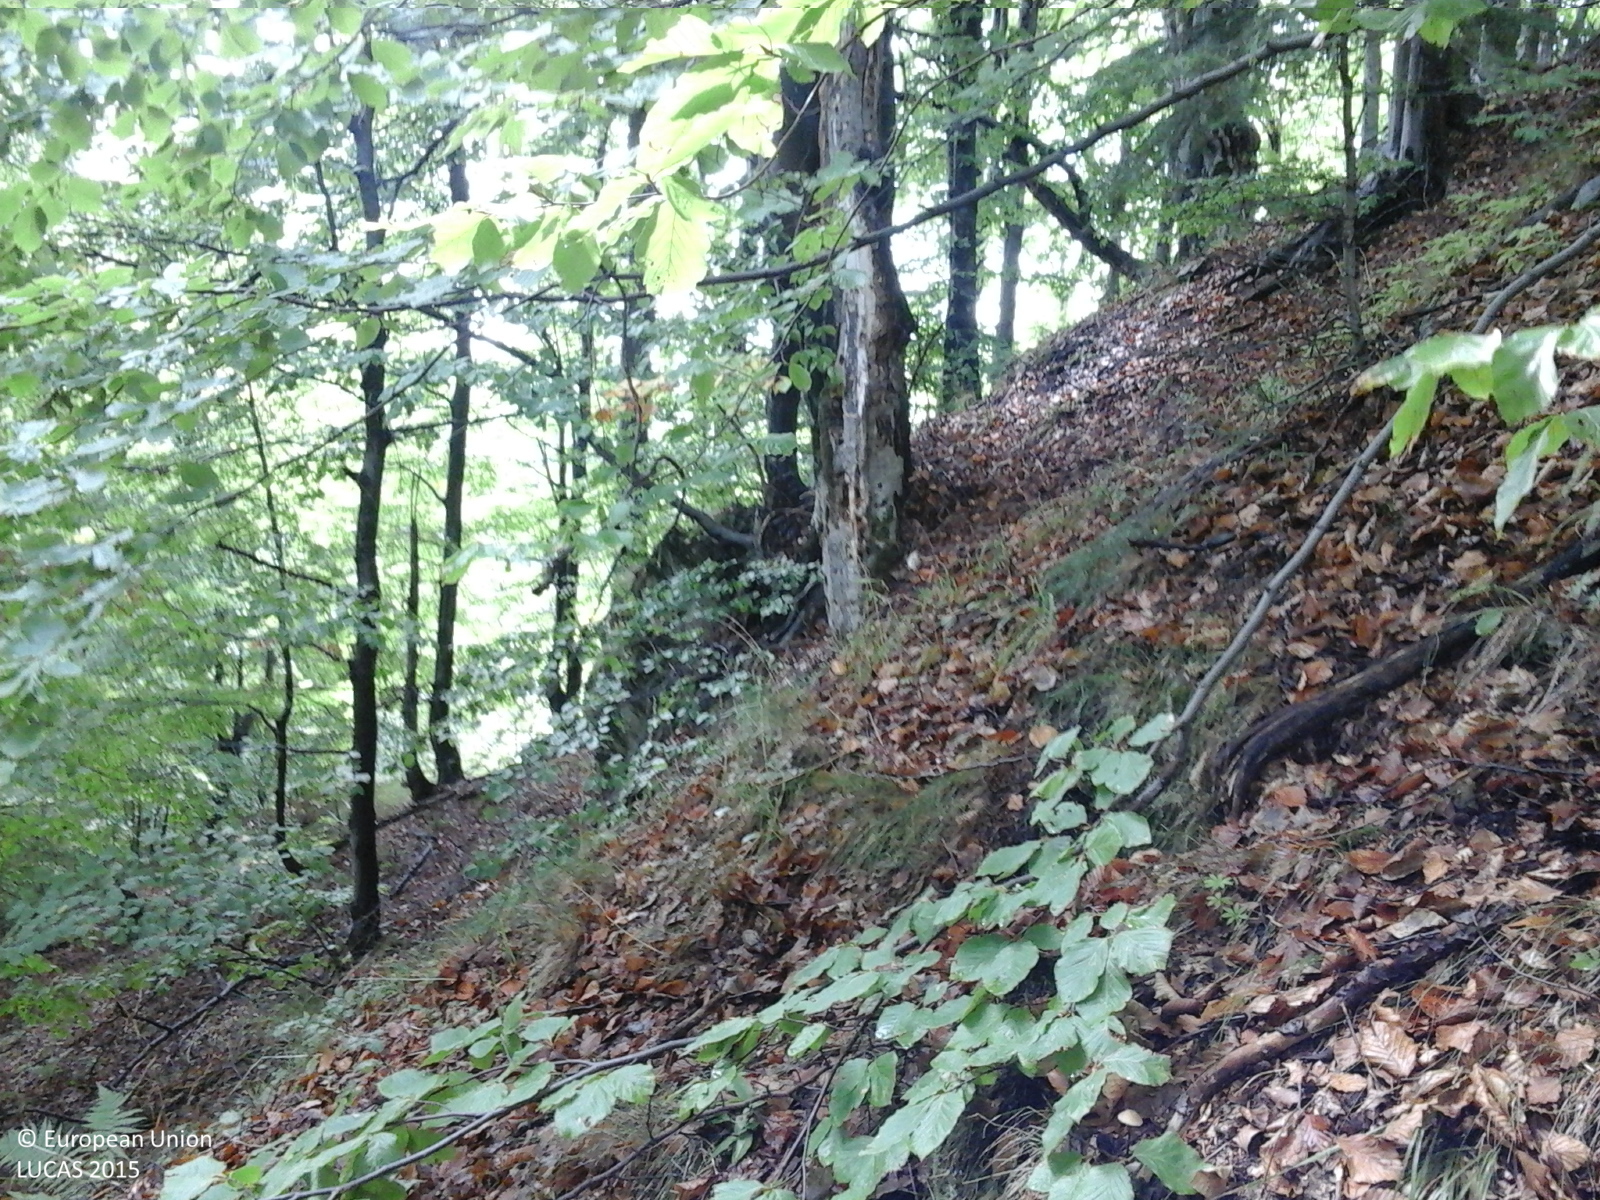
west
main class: Woodland
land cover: Broadleaved woodland
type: beech forest
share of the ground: > 75 %
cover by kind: broadleaved forest trees 100 %
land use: Forestry
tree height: > 5 m
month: September
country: RO
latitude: 45.2612
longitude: 23.2968
